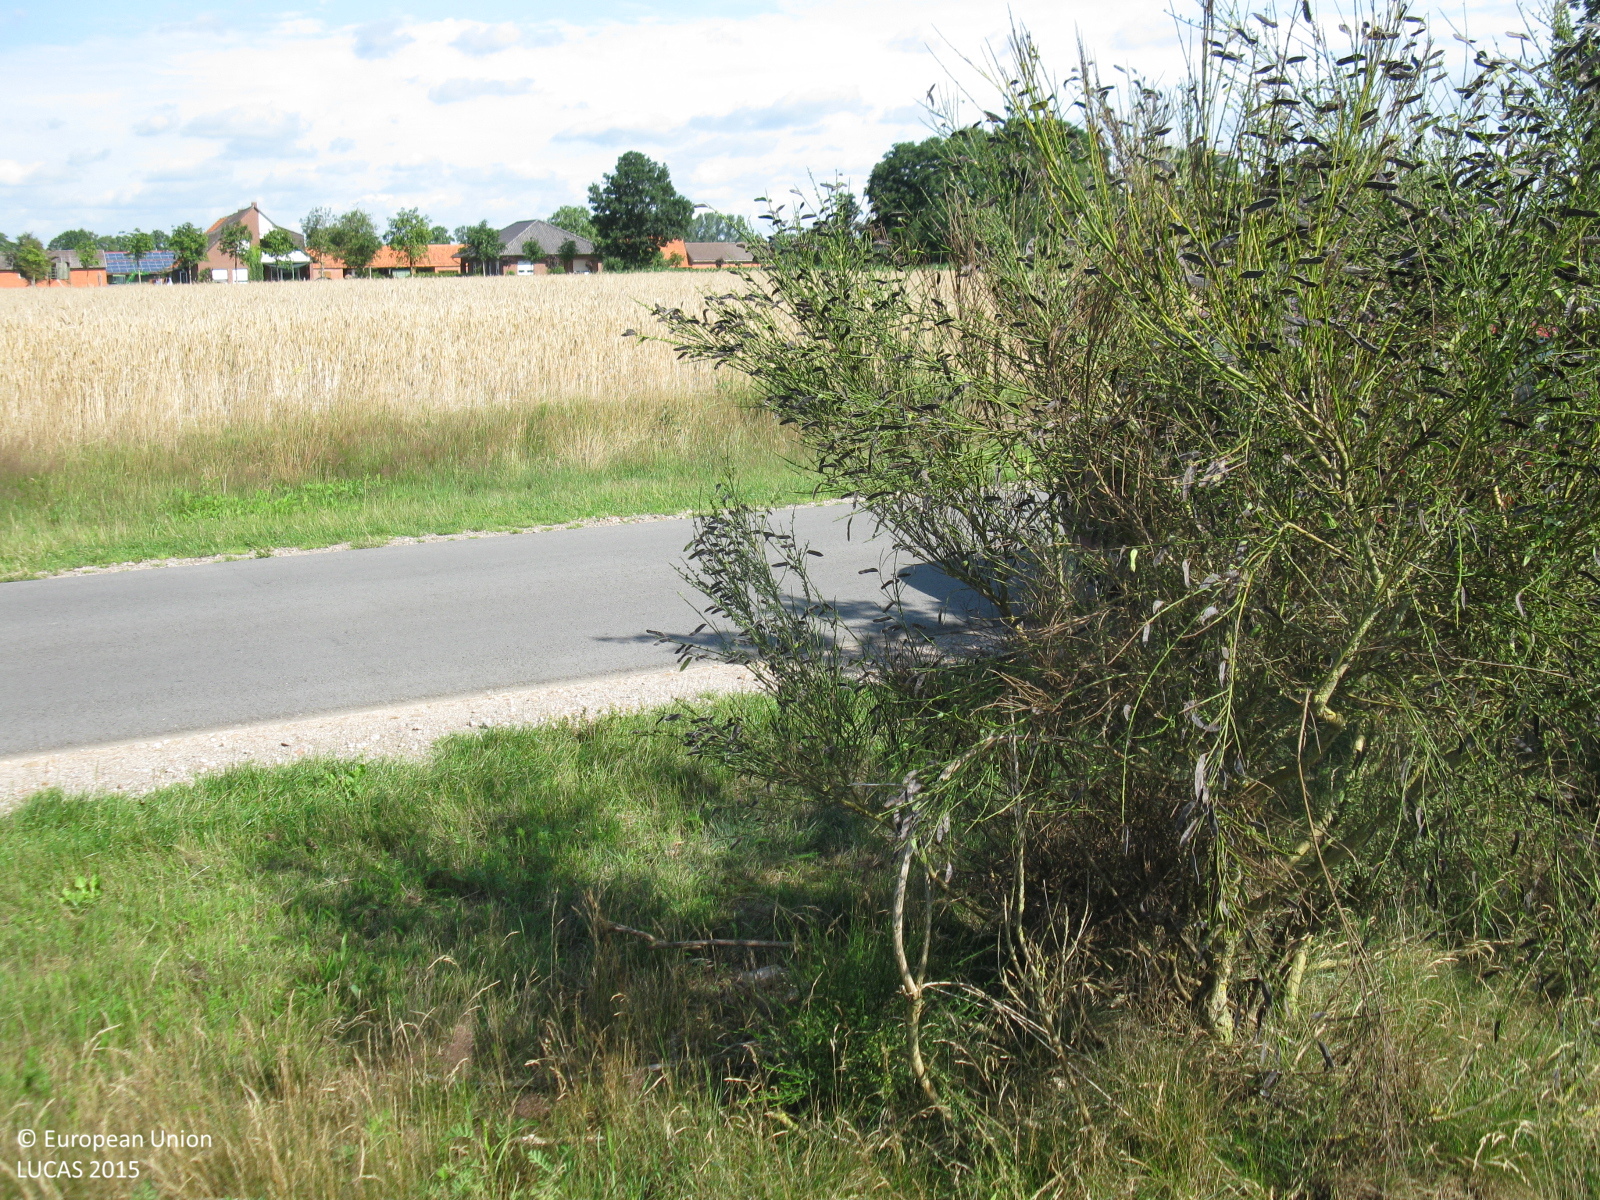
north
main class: Cropland
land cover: Triticale
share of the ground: > 75 %
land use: Agriculture (excluding fallow land and kitchen gardens)
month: July
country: DE
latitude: 52.9882
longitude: 7.9002
